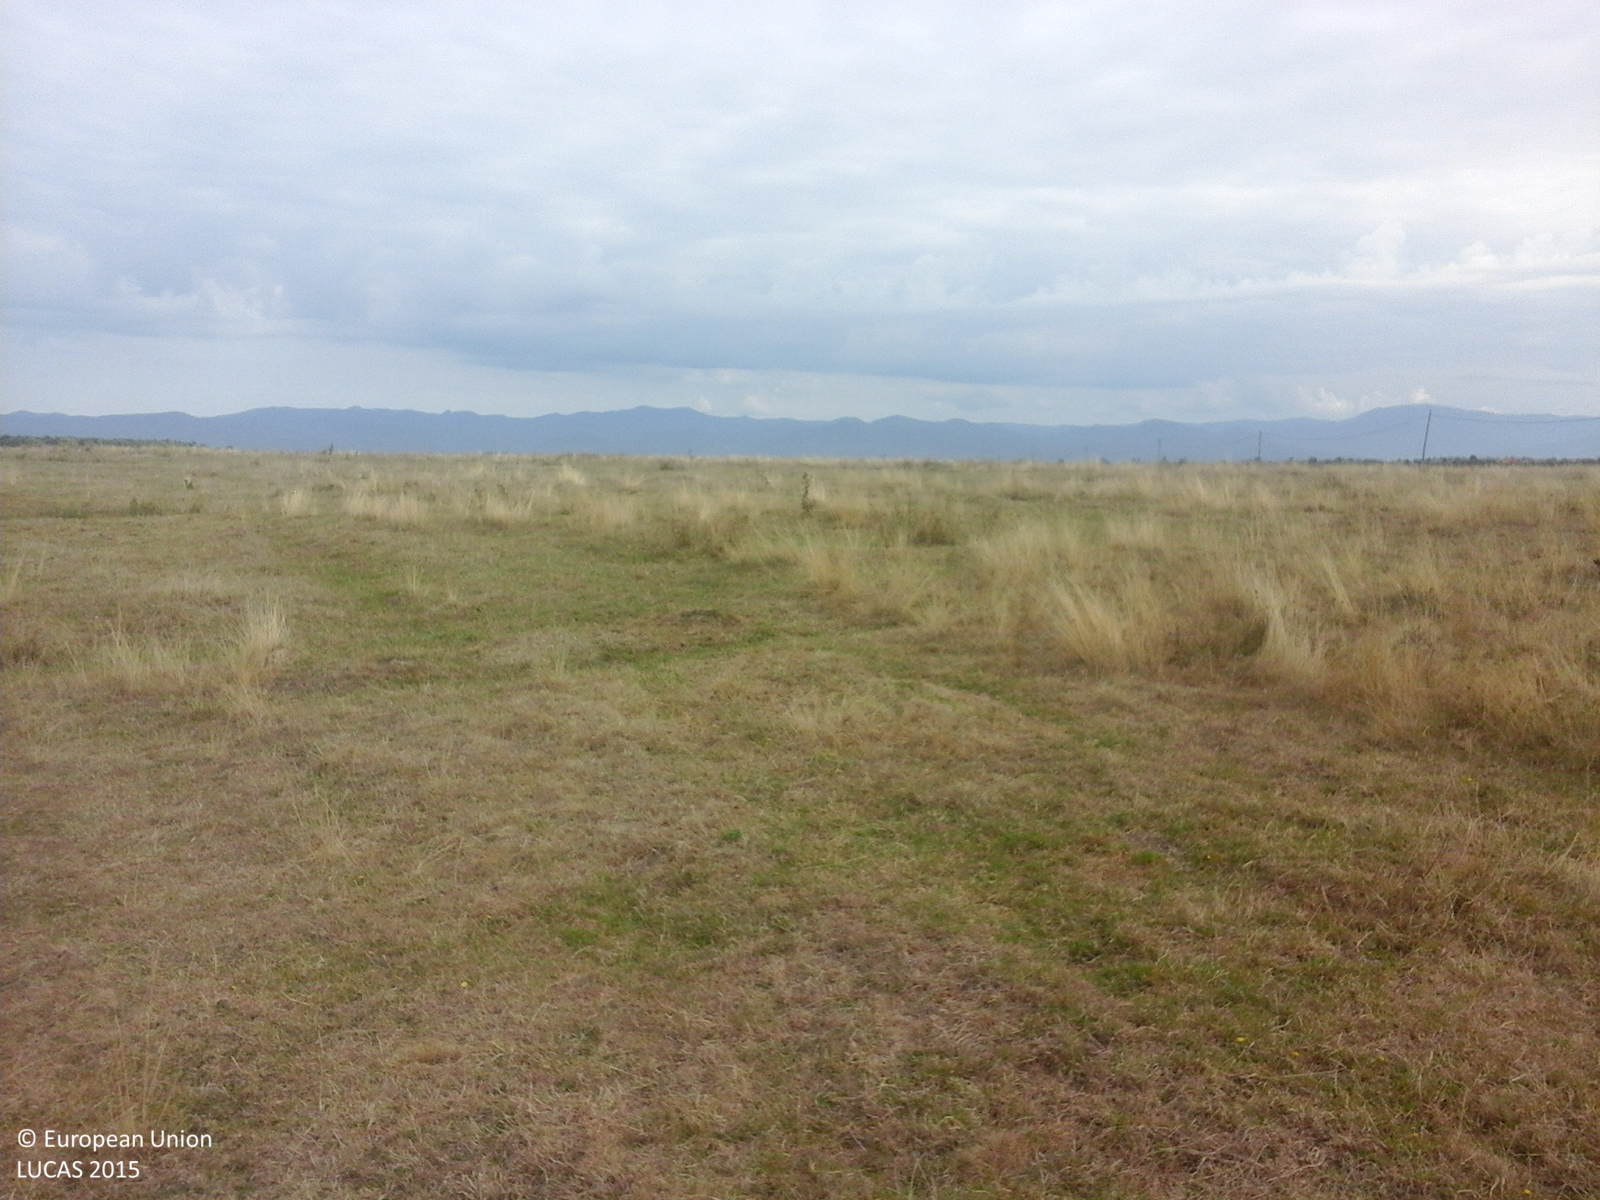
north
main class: Grassland
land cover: Grassland without tree/shrub cover
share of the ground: > 75 %
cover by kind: herbaceous plants 100 %
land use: Agriculture (excluding fallow land and kitchen gardens)
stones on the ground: < 10 %
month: September
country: RO
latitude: 47.5371
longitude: 23.4777
